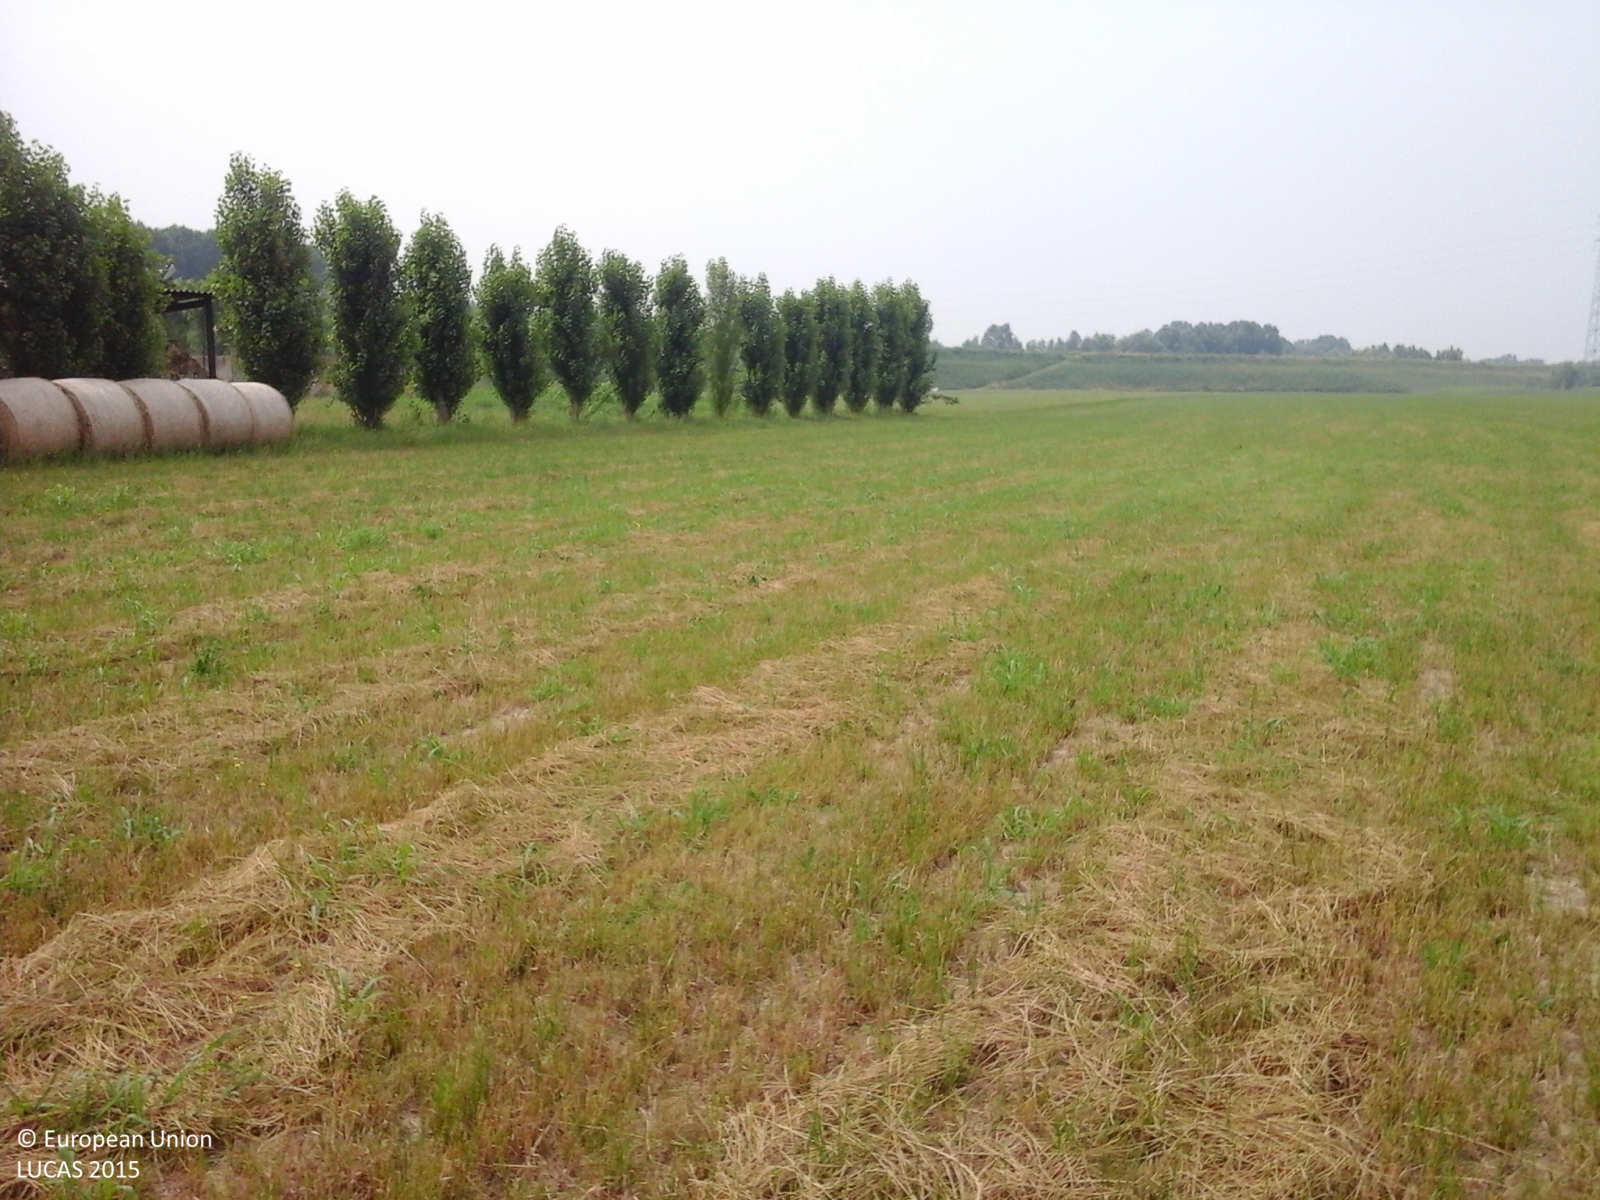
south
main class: Grassland
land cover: Grassland without tree/shrub cover
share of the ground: > 75 %
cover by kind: herbaceous plants 100 %
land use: Agriculture (excluding fallow land and kitchen gardens)
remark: Harvested field
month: June
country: IT
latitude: 44.7248
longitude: 10.9701
